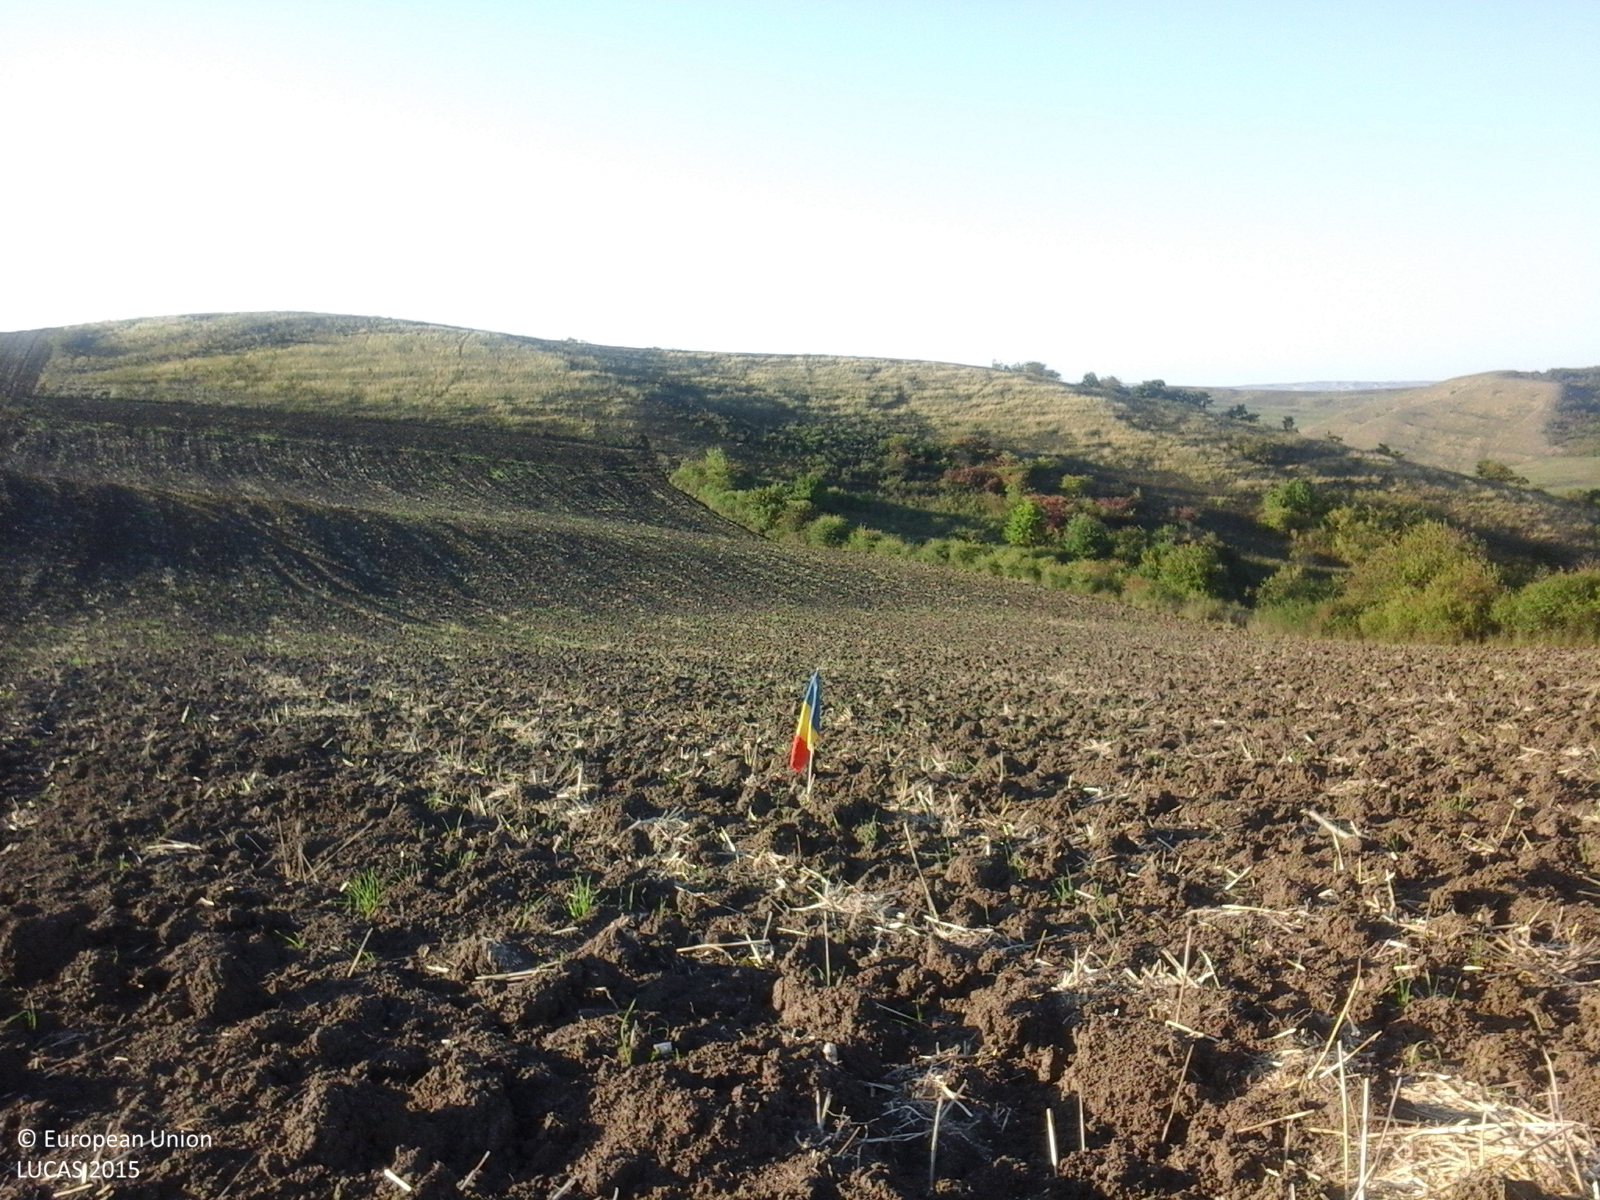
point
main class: Cropland
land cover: Common wheat
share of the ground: < 10 %
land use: Agriculture (excluding fallow land and kitchen gardens)
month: October
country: RO
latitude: 46.1775
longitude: 23.9737
